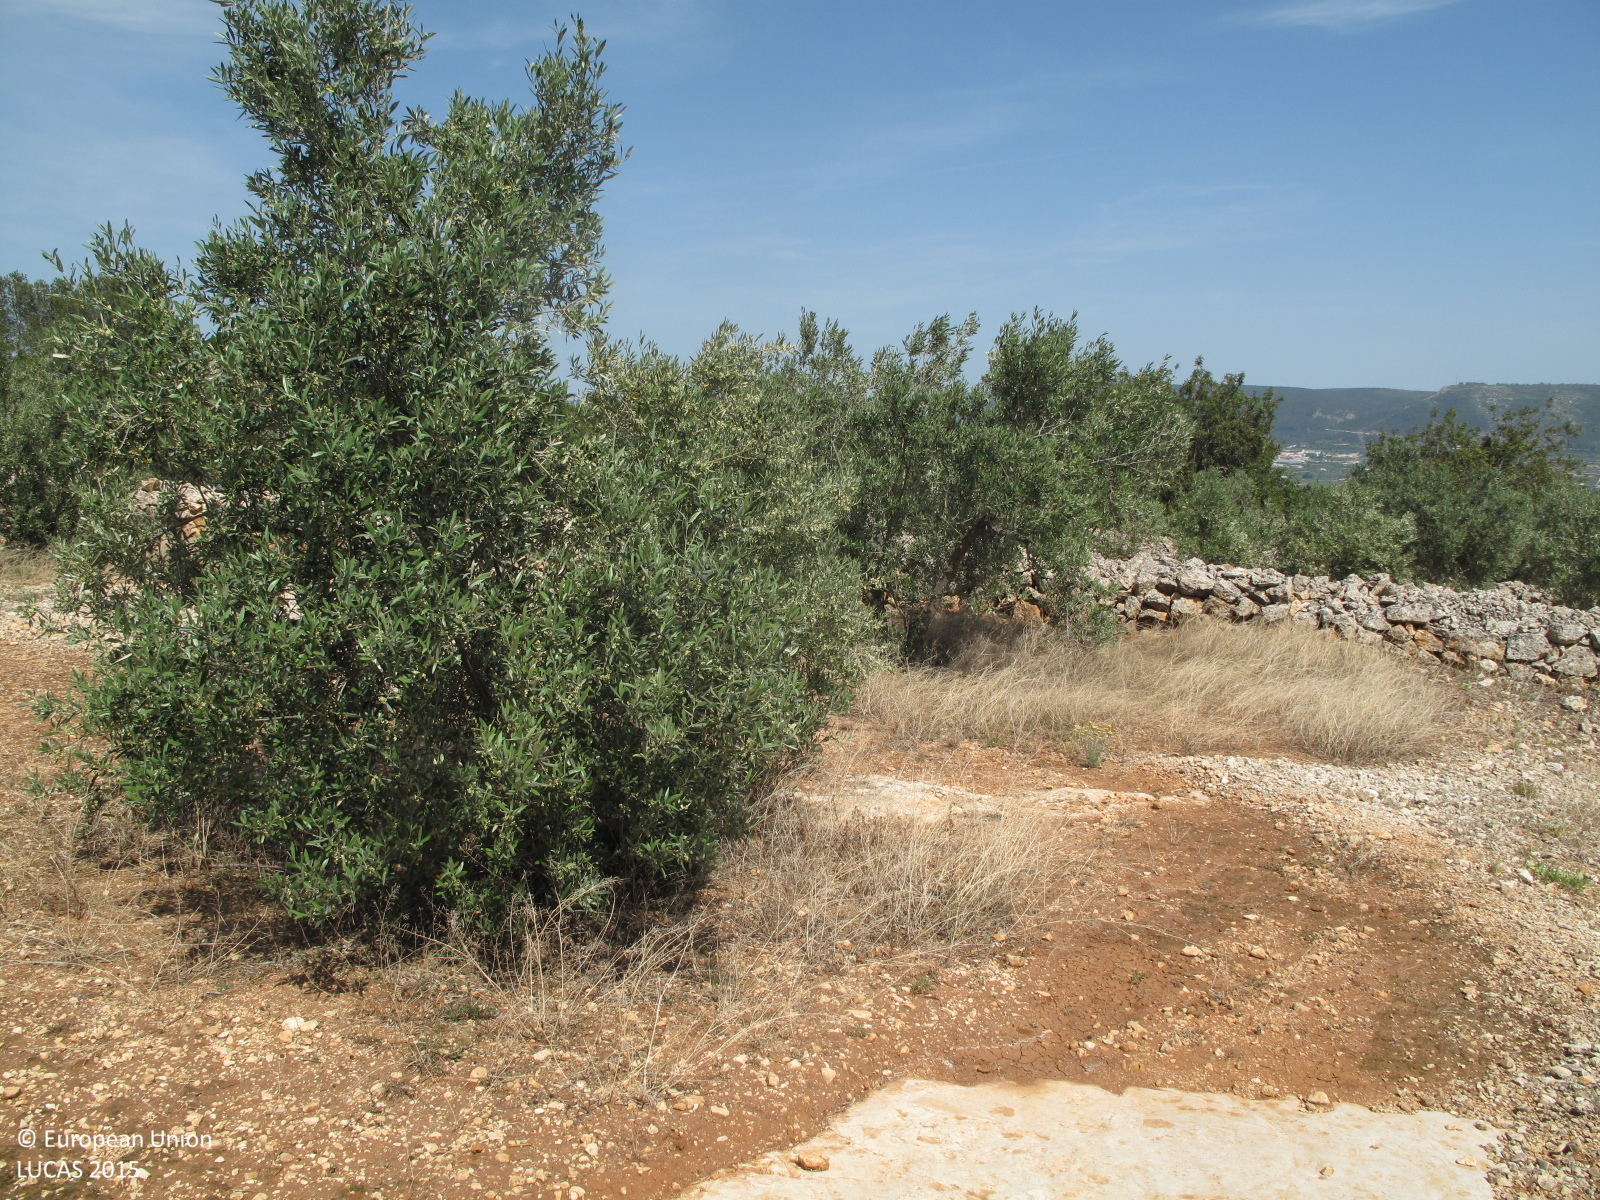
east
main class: Cropland
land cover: Olive groves
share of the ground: 10 - 25 %
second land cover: Spontaneously vegetated surfaces
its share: 25 - 50 %
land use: Agriculture (excluding fallow land and kitchen gardens)
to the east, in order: Olive groves; Spontaneously vegetated surfaces; Dry stone walls; Olive groves; Dry stone walls; Permanent industrial crops; Olive groves; Dry stone walls; Olive groves; Shrubland with sparse tree cover; Dry stone walls; Olive groves; Dry stone walls; Olive groves; Dry stone walls; Permanent industrial crops; Artificial constructions in urban areas; Dry stone walls; Olive groves; Dry stone walls; Olive groves; Shruby margins; Olive groves
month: May
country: ES
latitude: 38.9825
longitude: -0.7410
